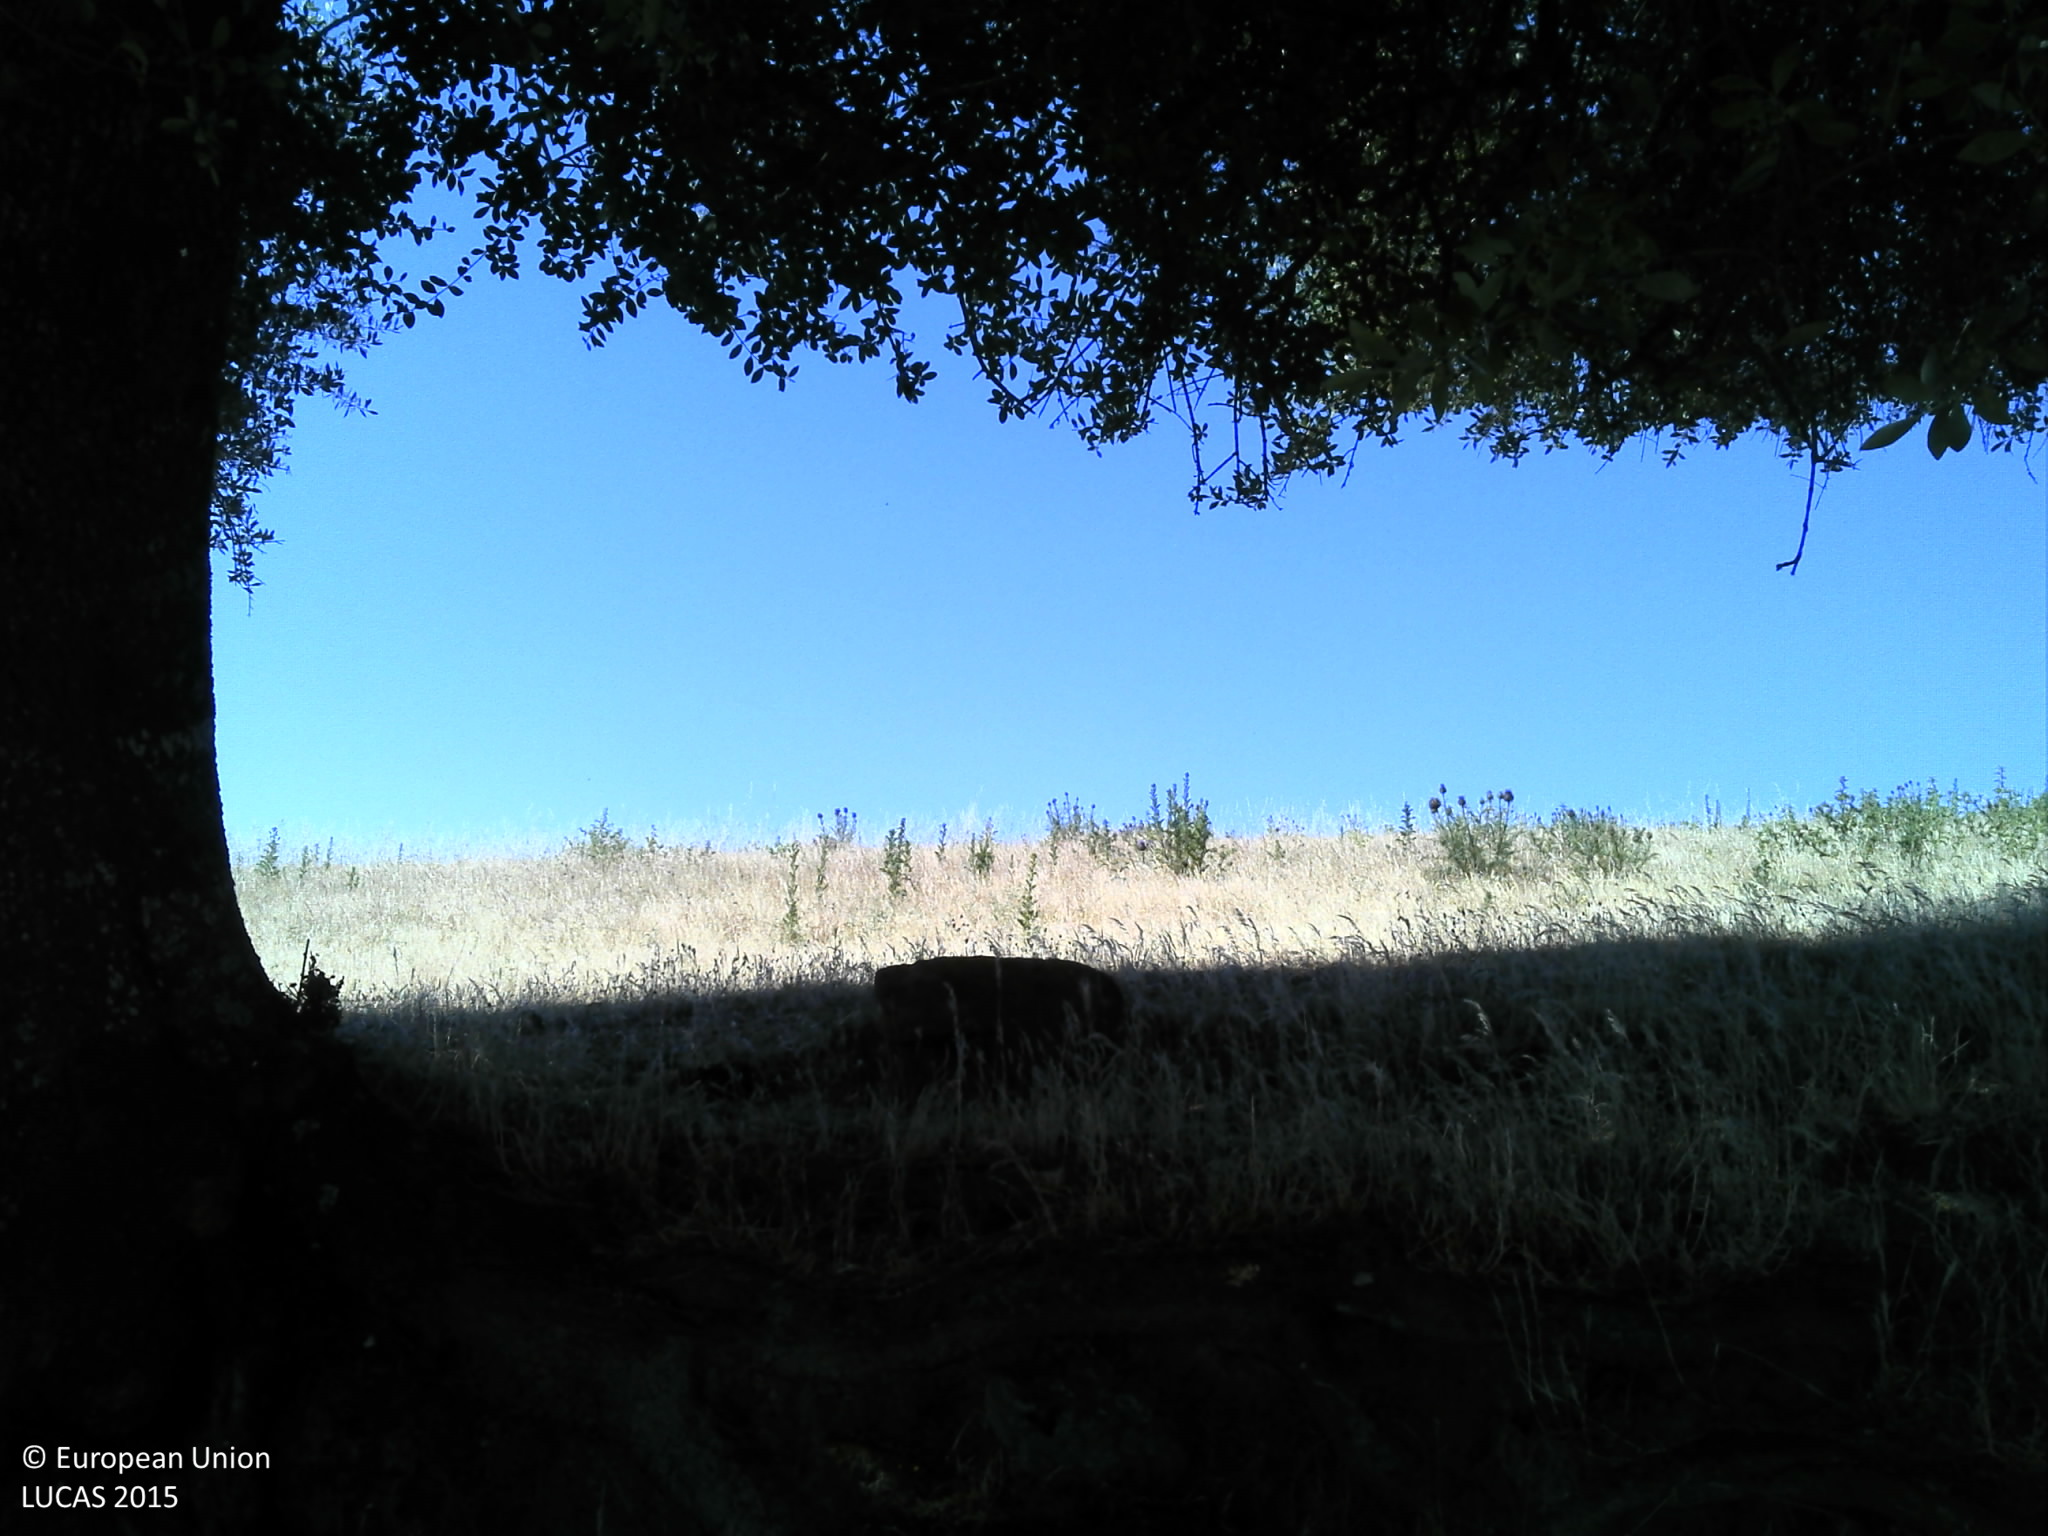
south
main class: Cropland
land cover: Olive groves
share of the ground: 10 - 25 %
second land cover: Grassland without tree/shrub cover
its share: > 75 %
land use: Agriculture (excluding fallow land and kitchen gardens)
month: June
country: PT
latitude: 38.6998
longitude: -8.0871
